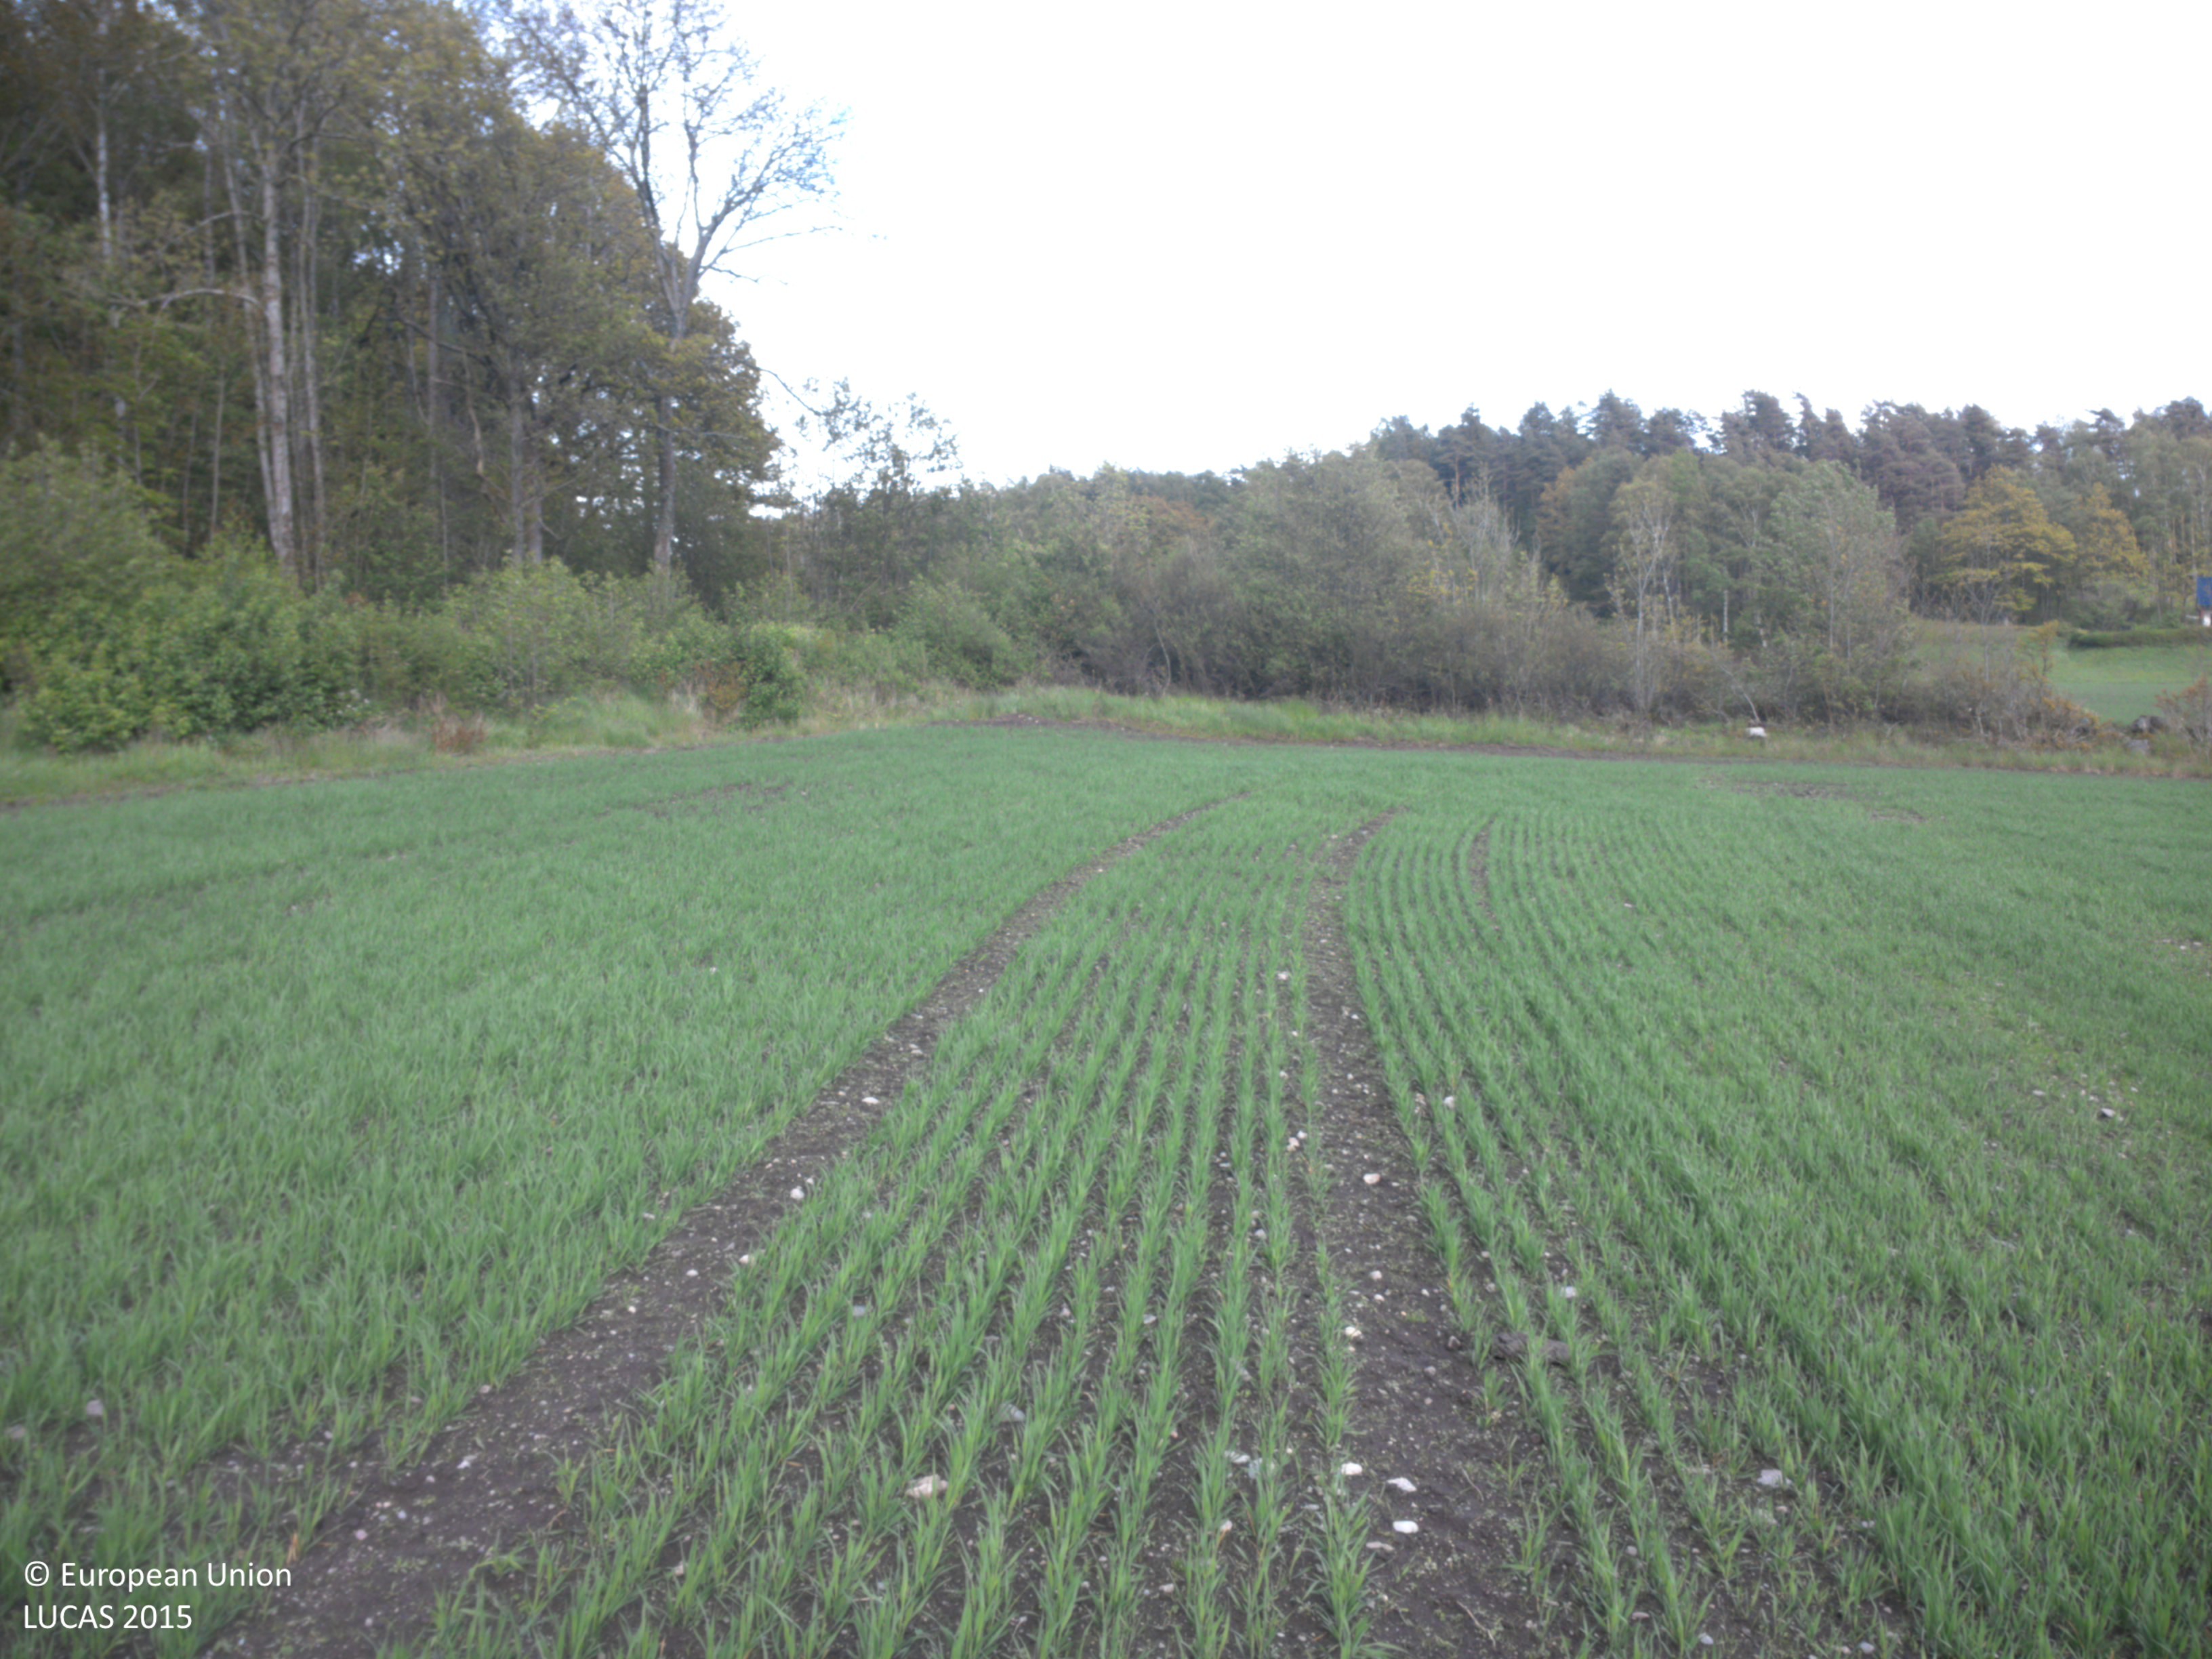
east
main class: Cropland
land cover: Common wheat
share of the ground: 50 - 75 %
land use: Agriculture (excluding fallow land and kitchen gardens)
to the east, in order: Common wheat; Grass margins; Abandoned hedges; Dry stone walls; Abandoned hedges; Ditches and canals; Common wheat; Ditches and canals; Grassland without tree/shrub cover; Ditches and canals; Broadleaved woodland; Tracks; Broadleaved woodland; Lichens and moss
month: May
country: SE
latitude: 58.3515
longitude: 11.7905
